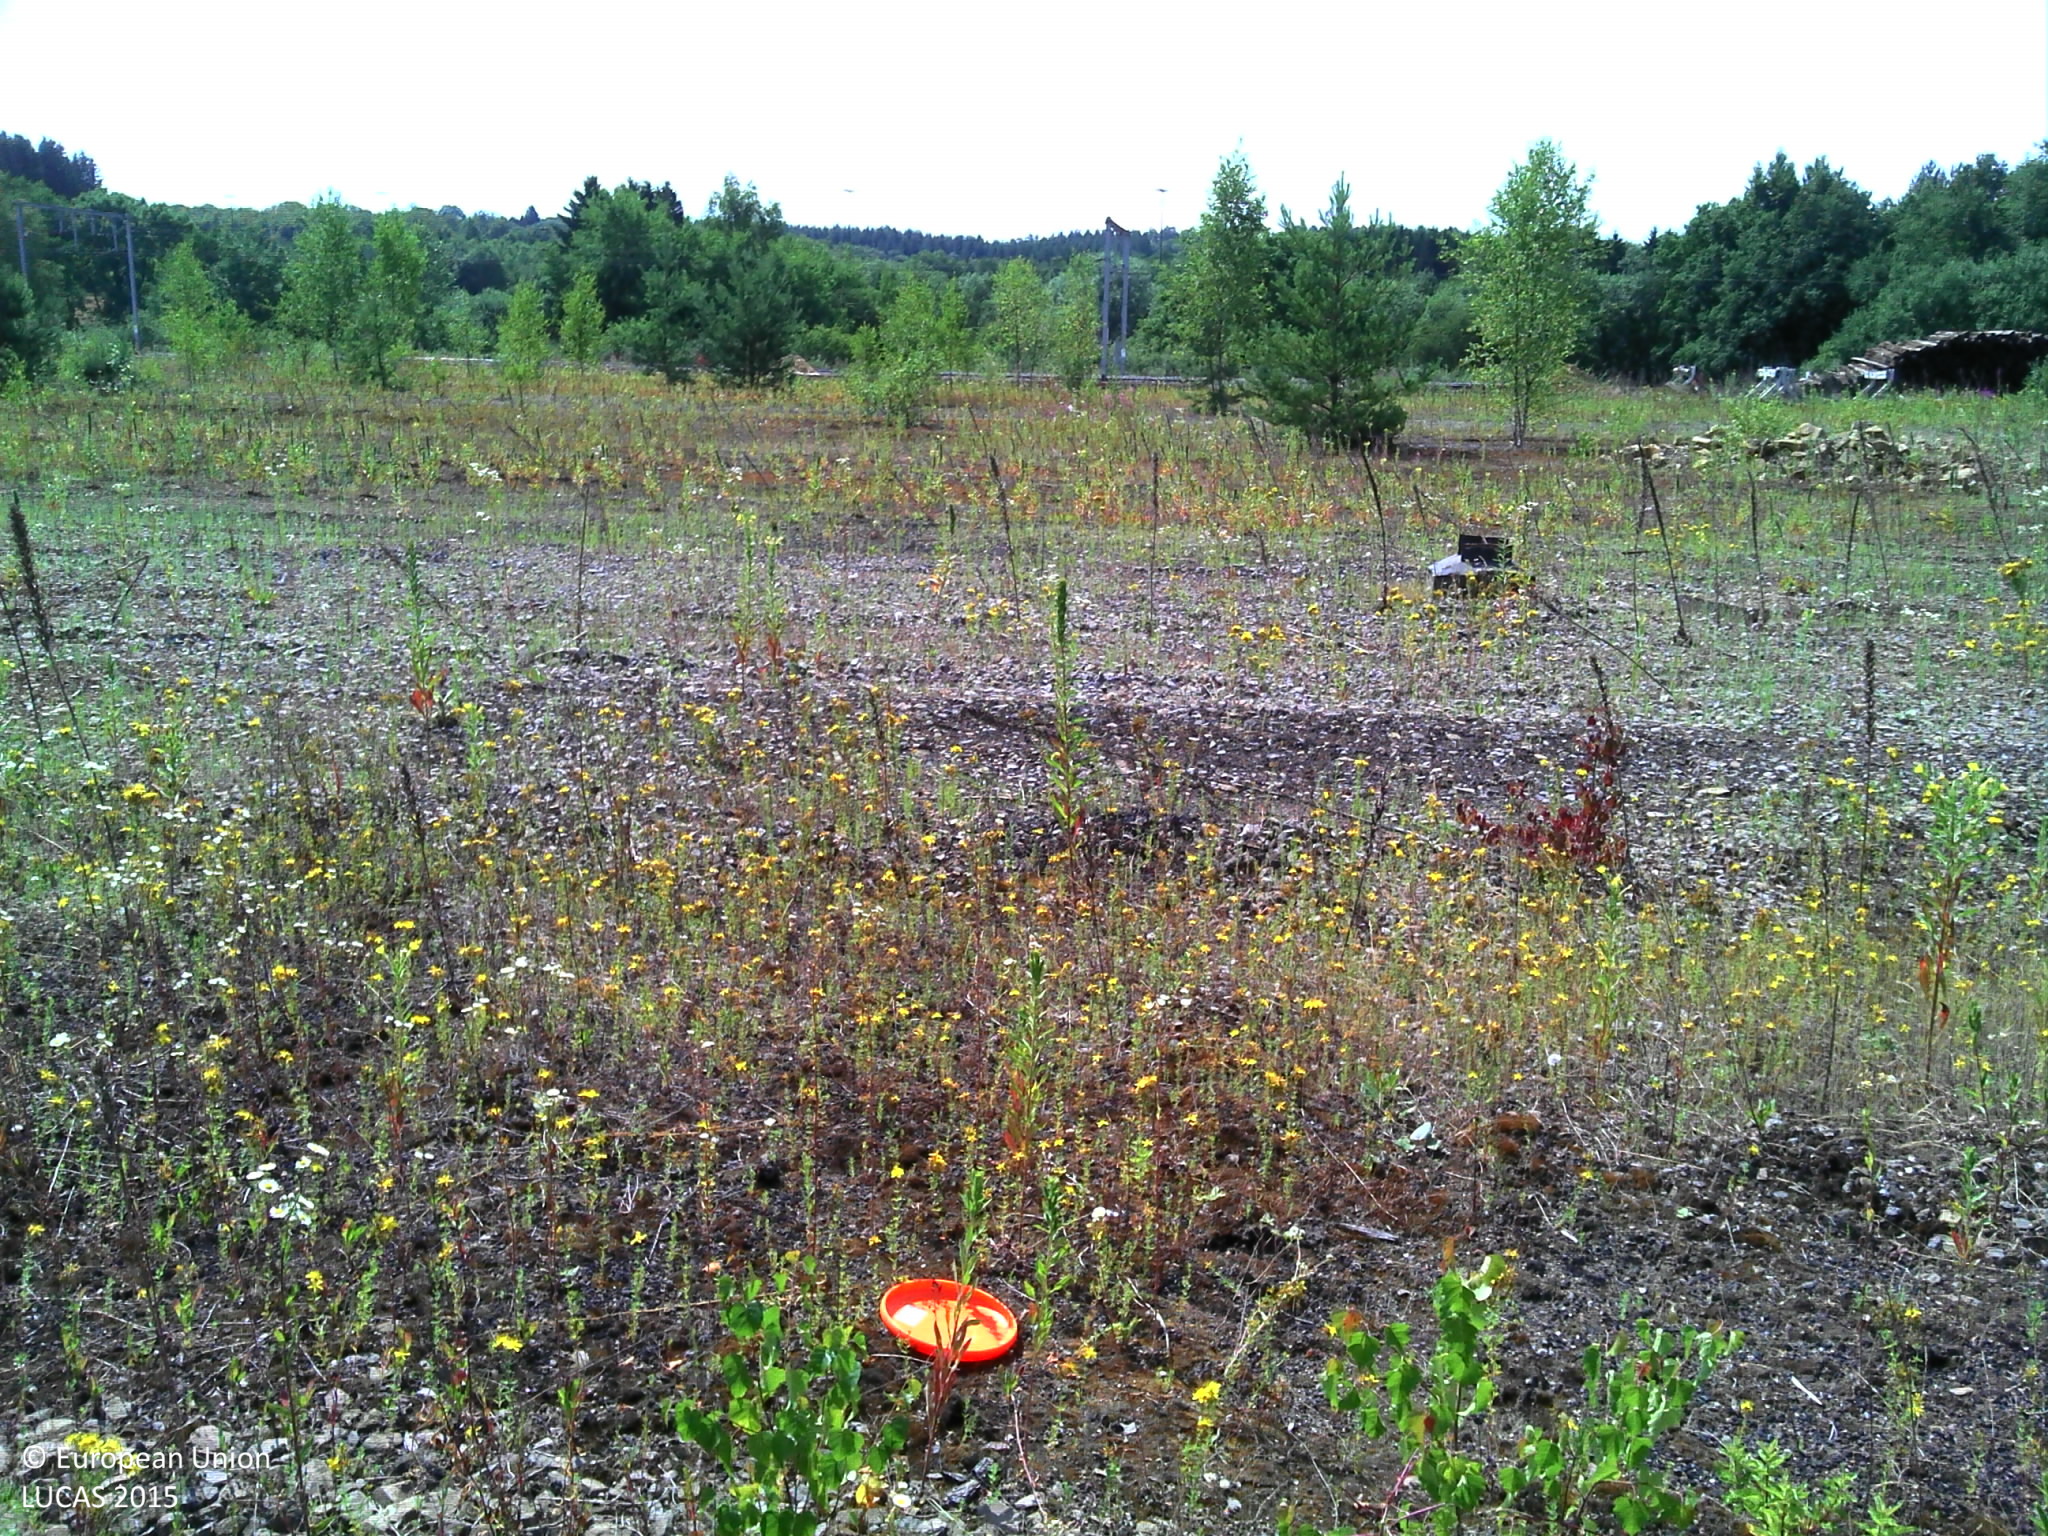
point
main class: Grassland
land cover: Spontaneously vegetated surfaces
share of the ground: 50 - 75 %
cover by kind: herbaceous plants 55 %, unconsolidated bare surface 40 %, shrubs 5 %
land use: Semi-natural and natural areas not in use
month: July
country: BE
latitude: 49.6906
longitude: 5.7432
